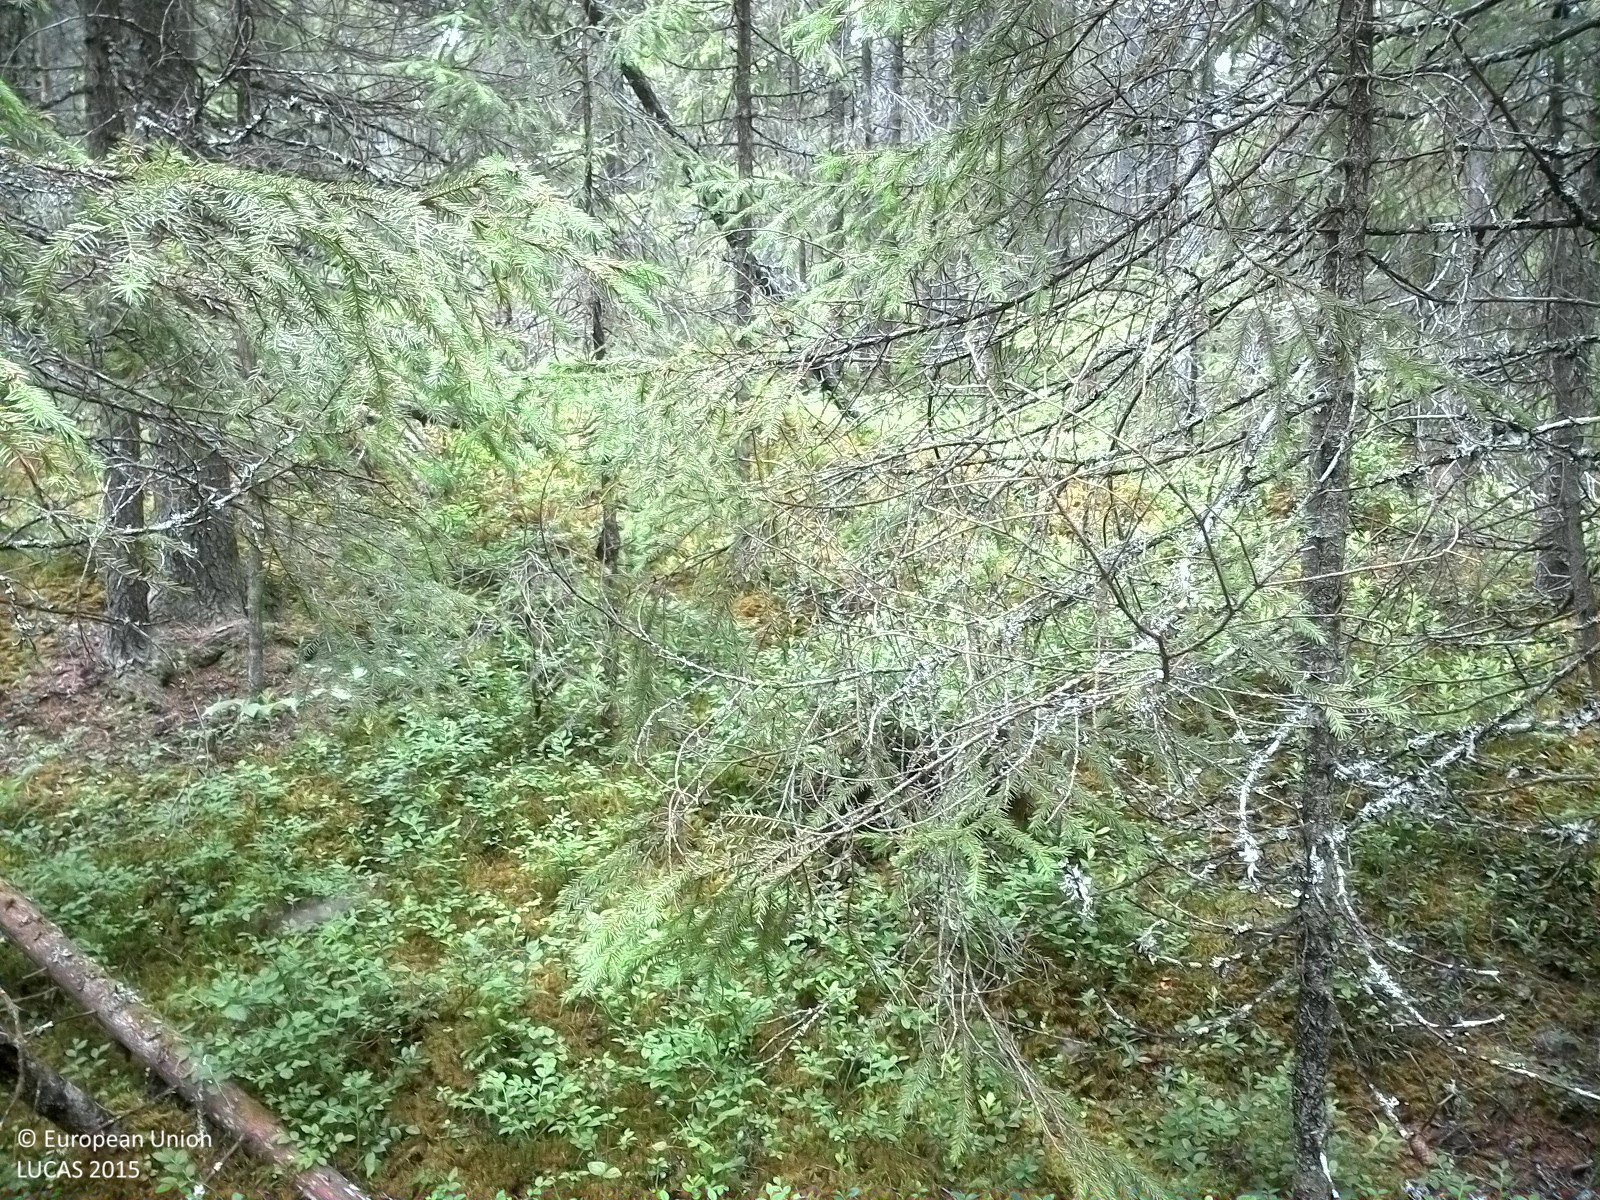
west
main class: Woodland
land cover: Spruce dominated coniferous woodland
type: boreal forest
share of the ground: > 75 %
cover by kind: coniferous forest trees 80 %, shrubs 15 %, broadleaved forest trees 5 %
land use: Forestry
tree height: > 5 m
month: July
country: SE
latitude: 63.5674
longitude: 15.3111
